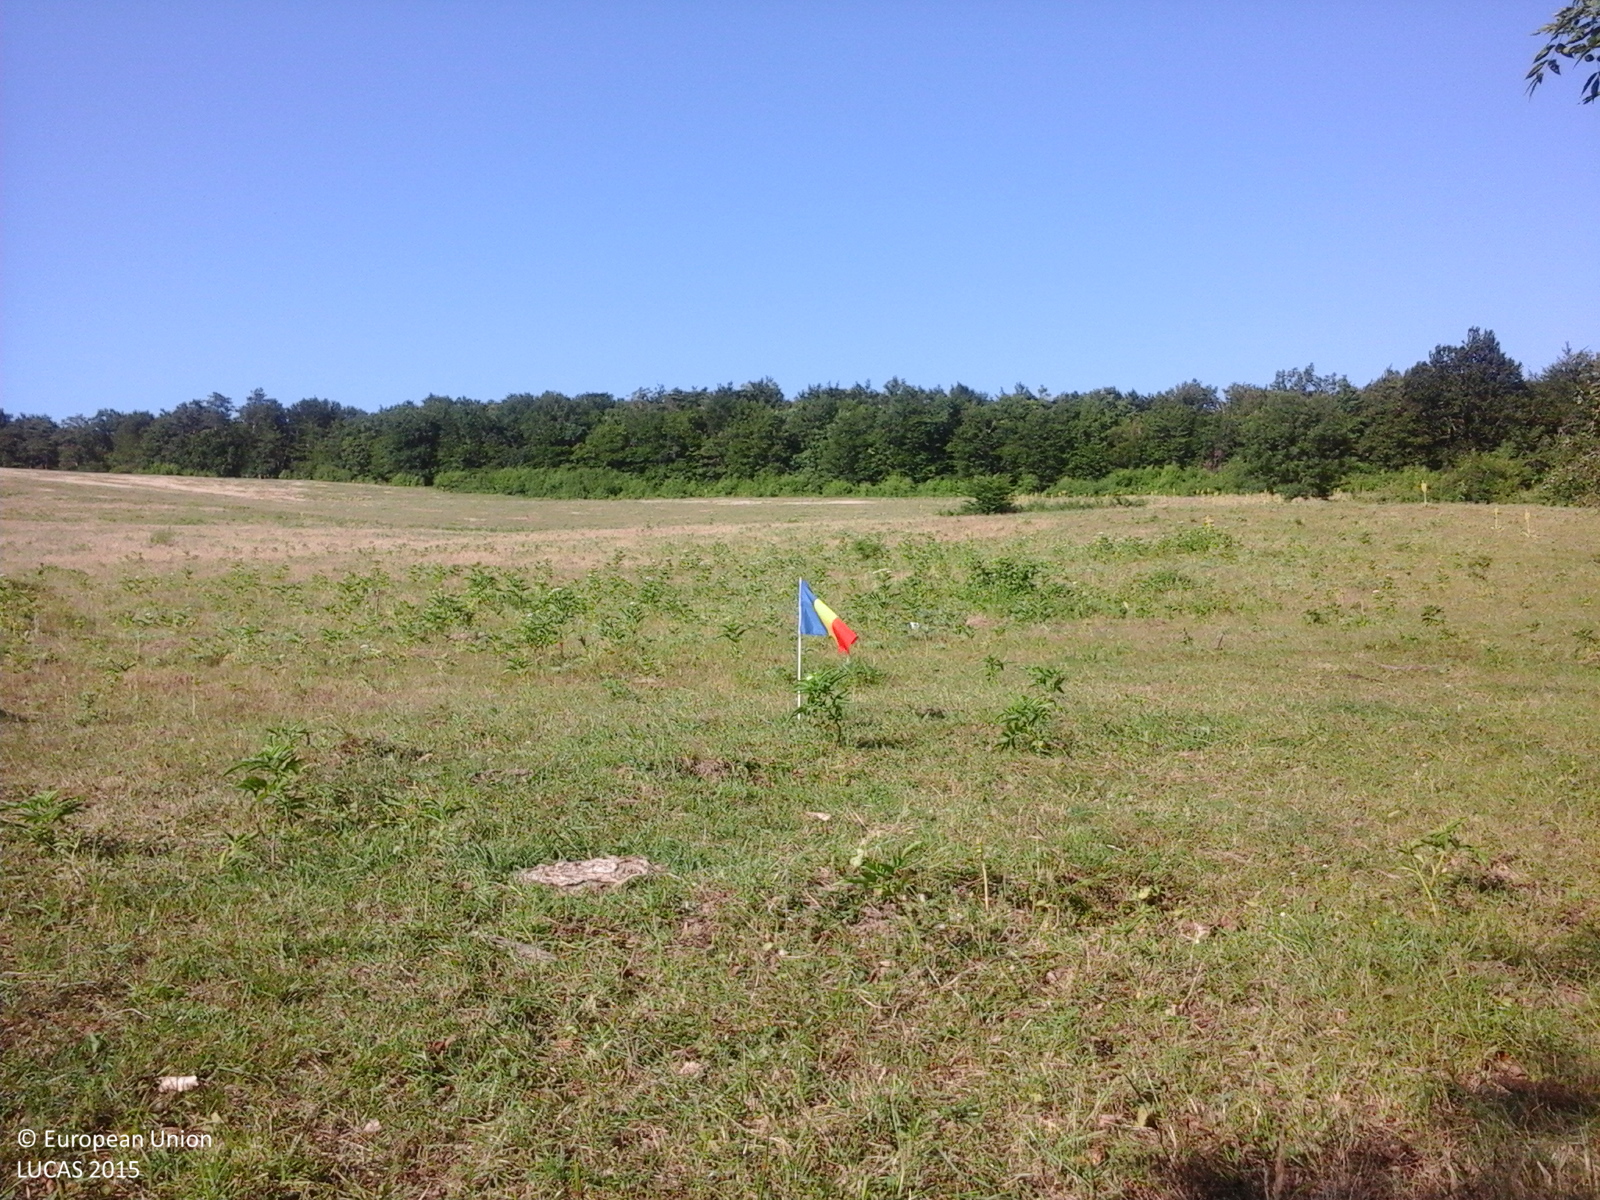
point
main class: Grassland
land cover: Grassland without tree/shrub cover
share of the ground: > 75 %
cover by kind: herbaceous plants 100 %
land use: Agriculture (excluding fallow land and kitchen gardens)
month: June
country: RO
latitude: 46.9828
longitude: 27.5623
